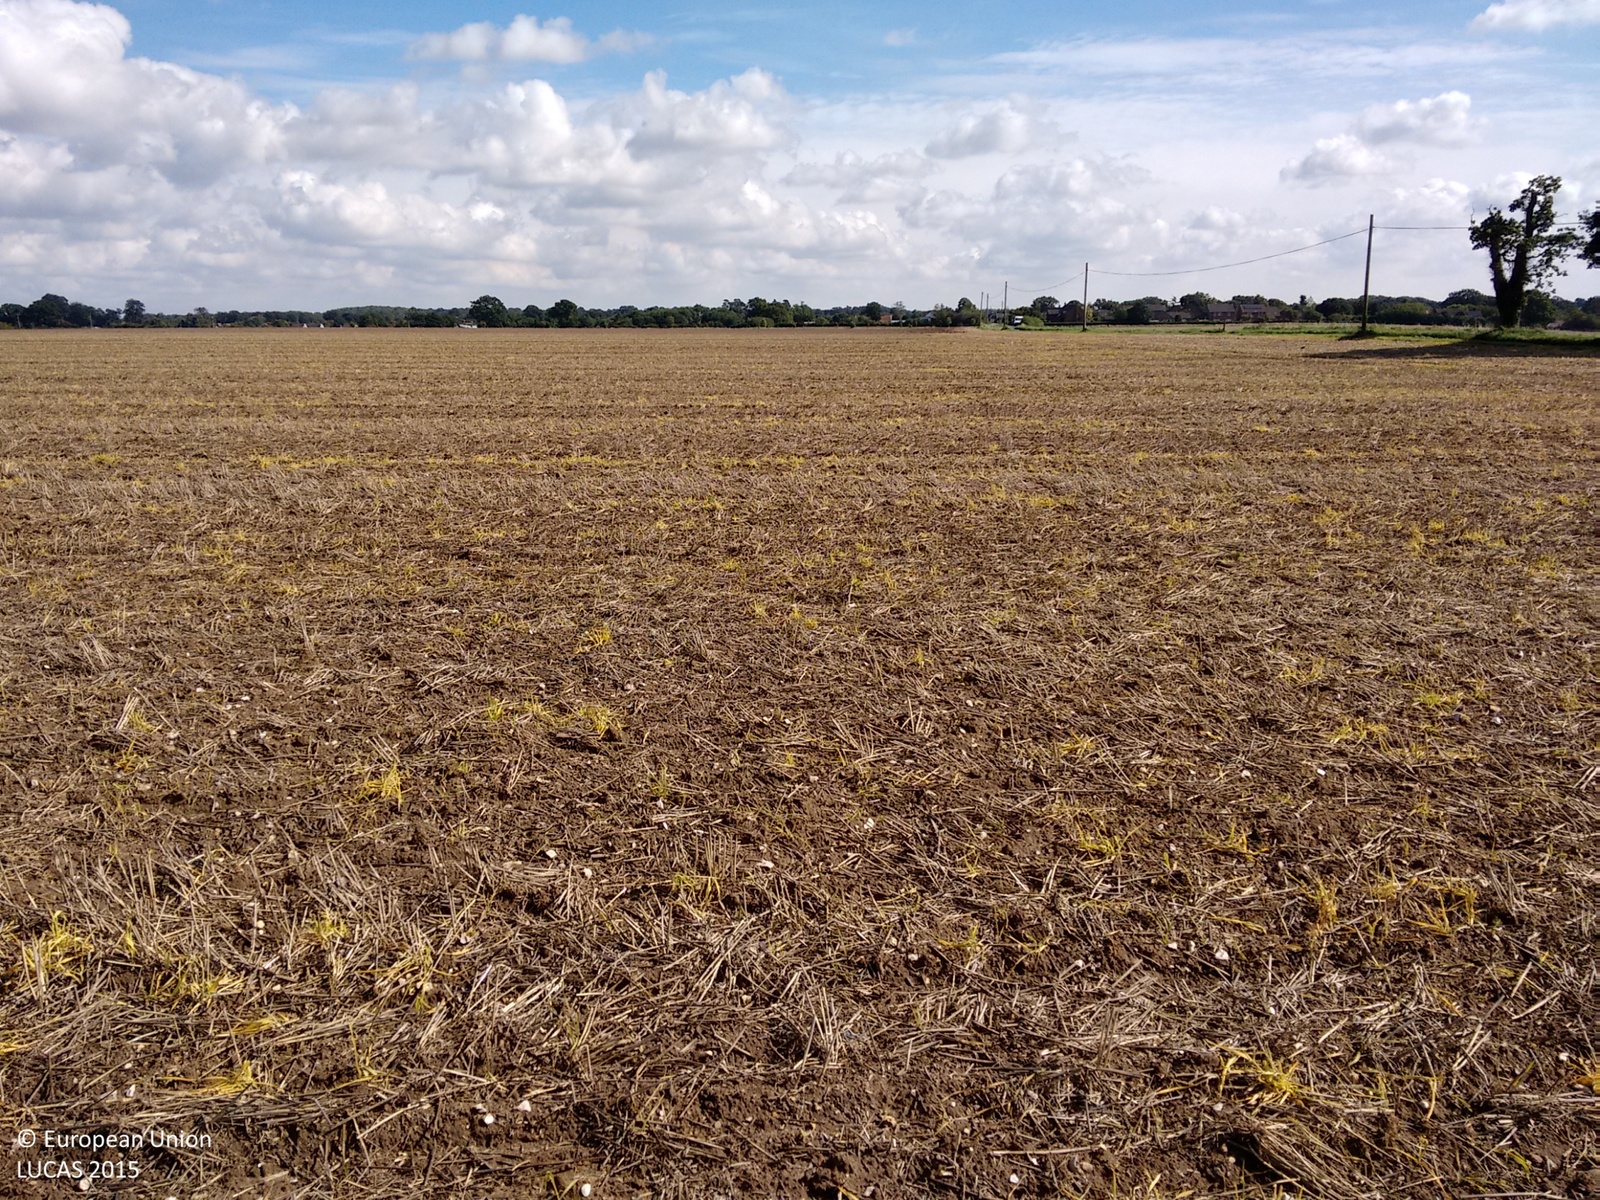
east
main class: Cropland
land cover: Common wheat
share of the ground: > 75 %
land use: Agriculture (excluding fallow land and kitchen gardens)
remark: Harvested field
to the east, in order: Common wheat; Other bare soil
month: September
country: GB
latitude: 52.4963
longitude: 1.3631
